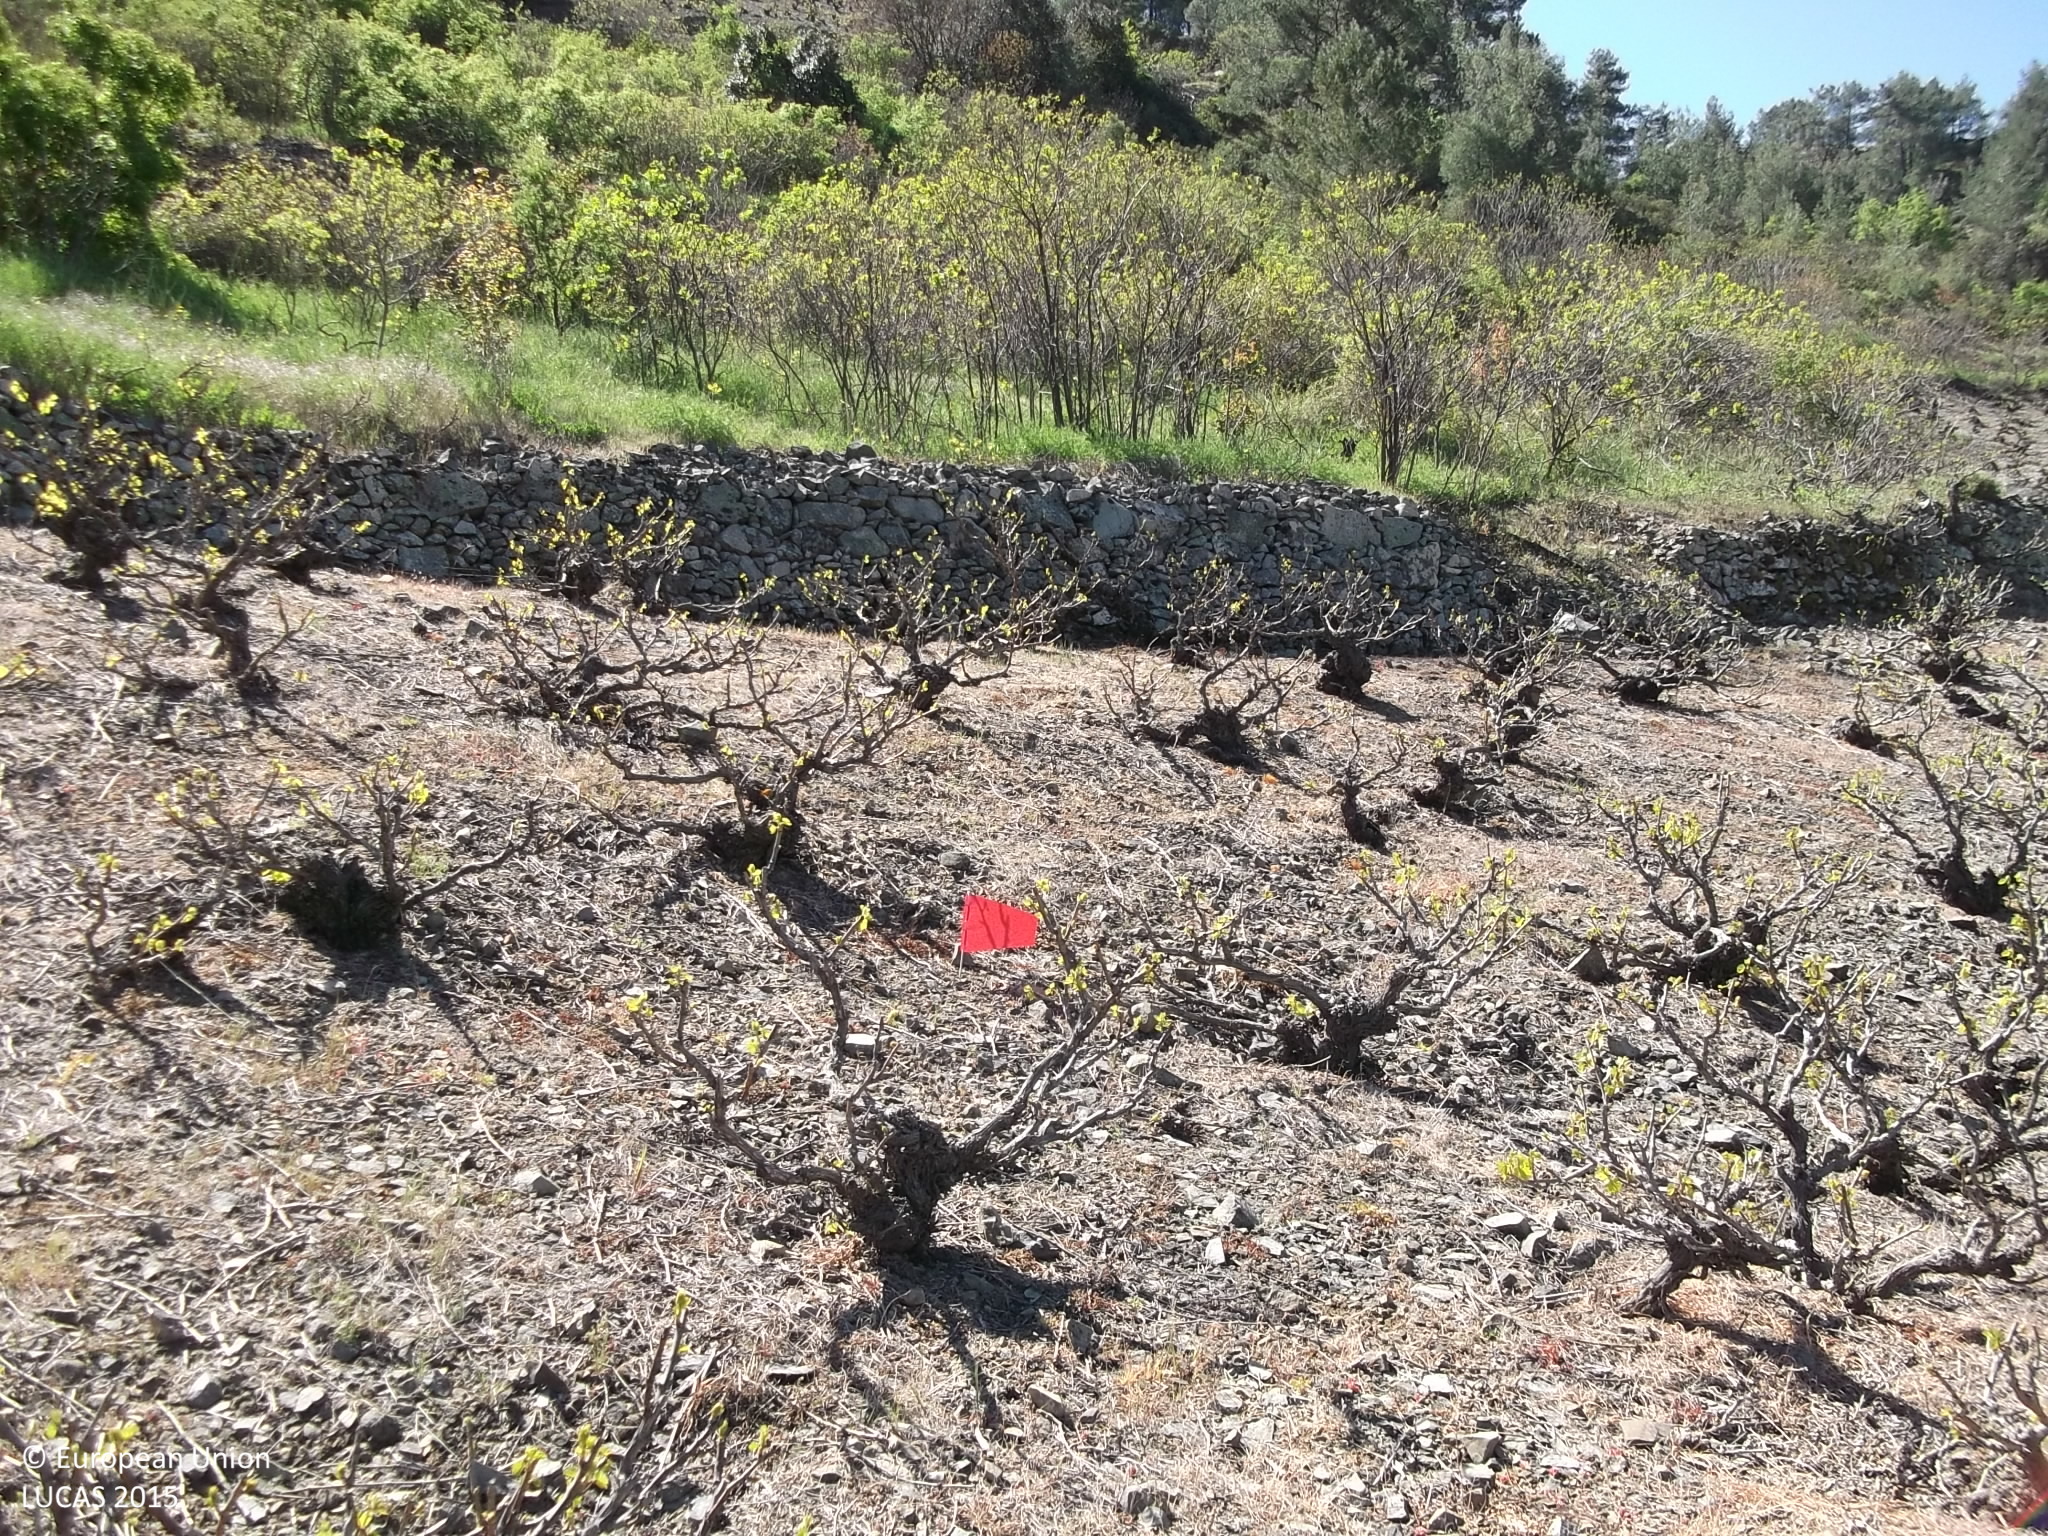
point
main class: Cropland
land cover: Vineyards
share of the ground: 10 - 25 %
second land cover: Rocks and stones
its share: > 75 %
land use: Agriculture (excluding fallow land and kitchen gardens)
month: April
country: CY
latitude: 34.8940
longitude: 33.1219
